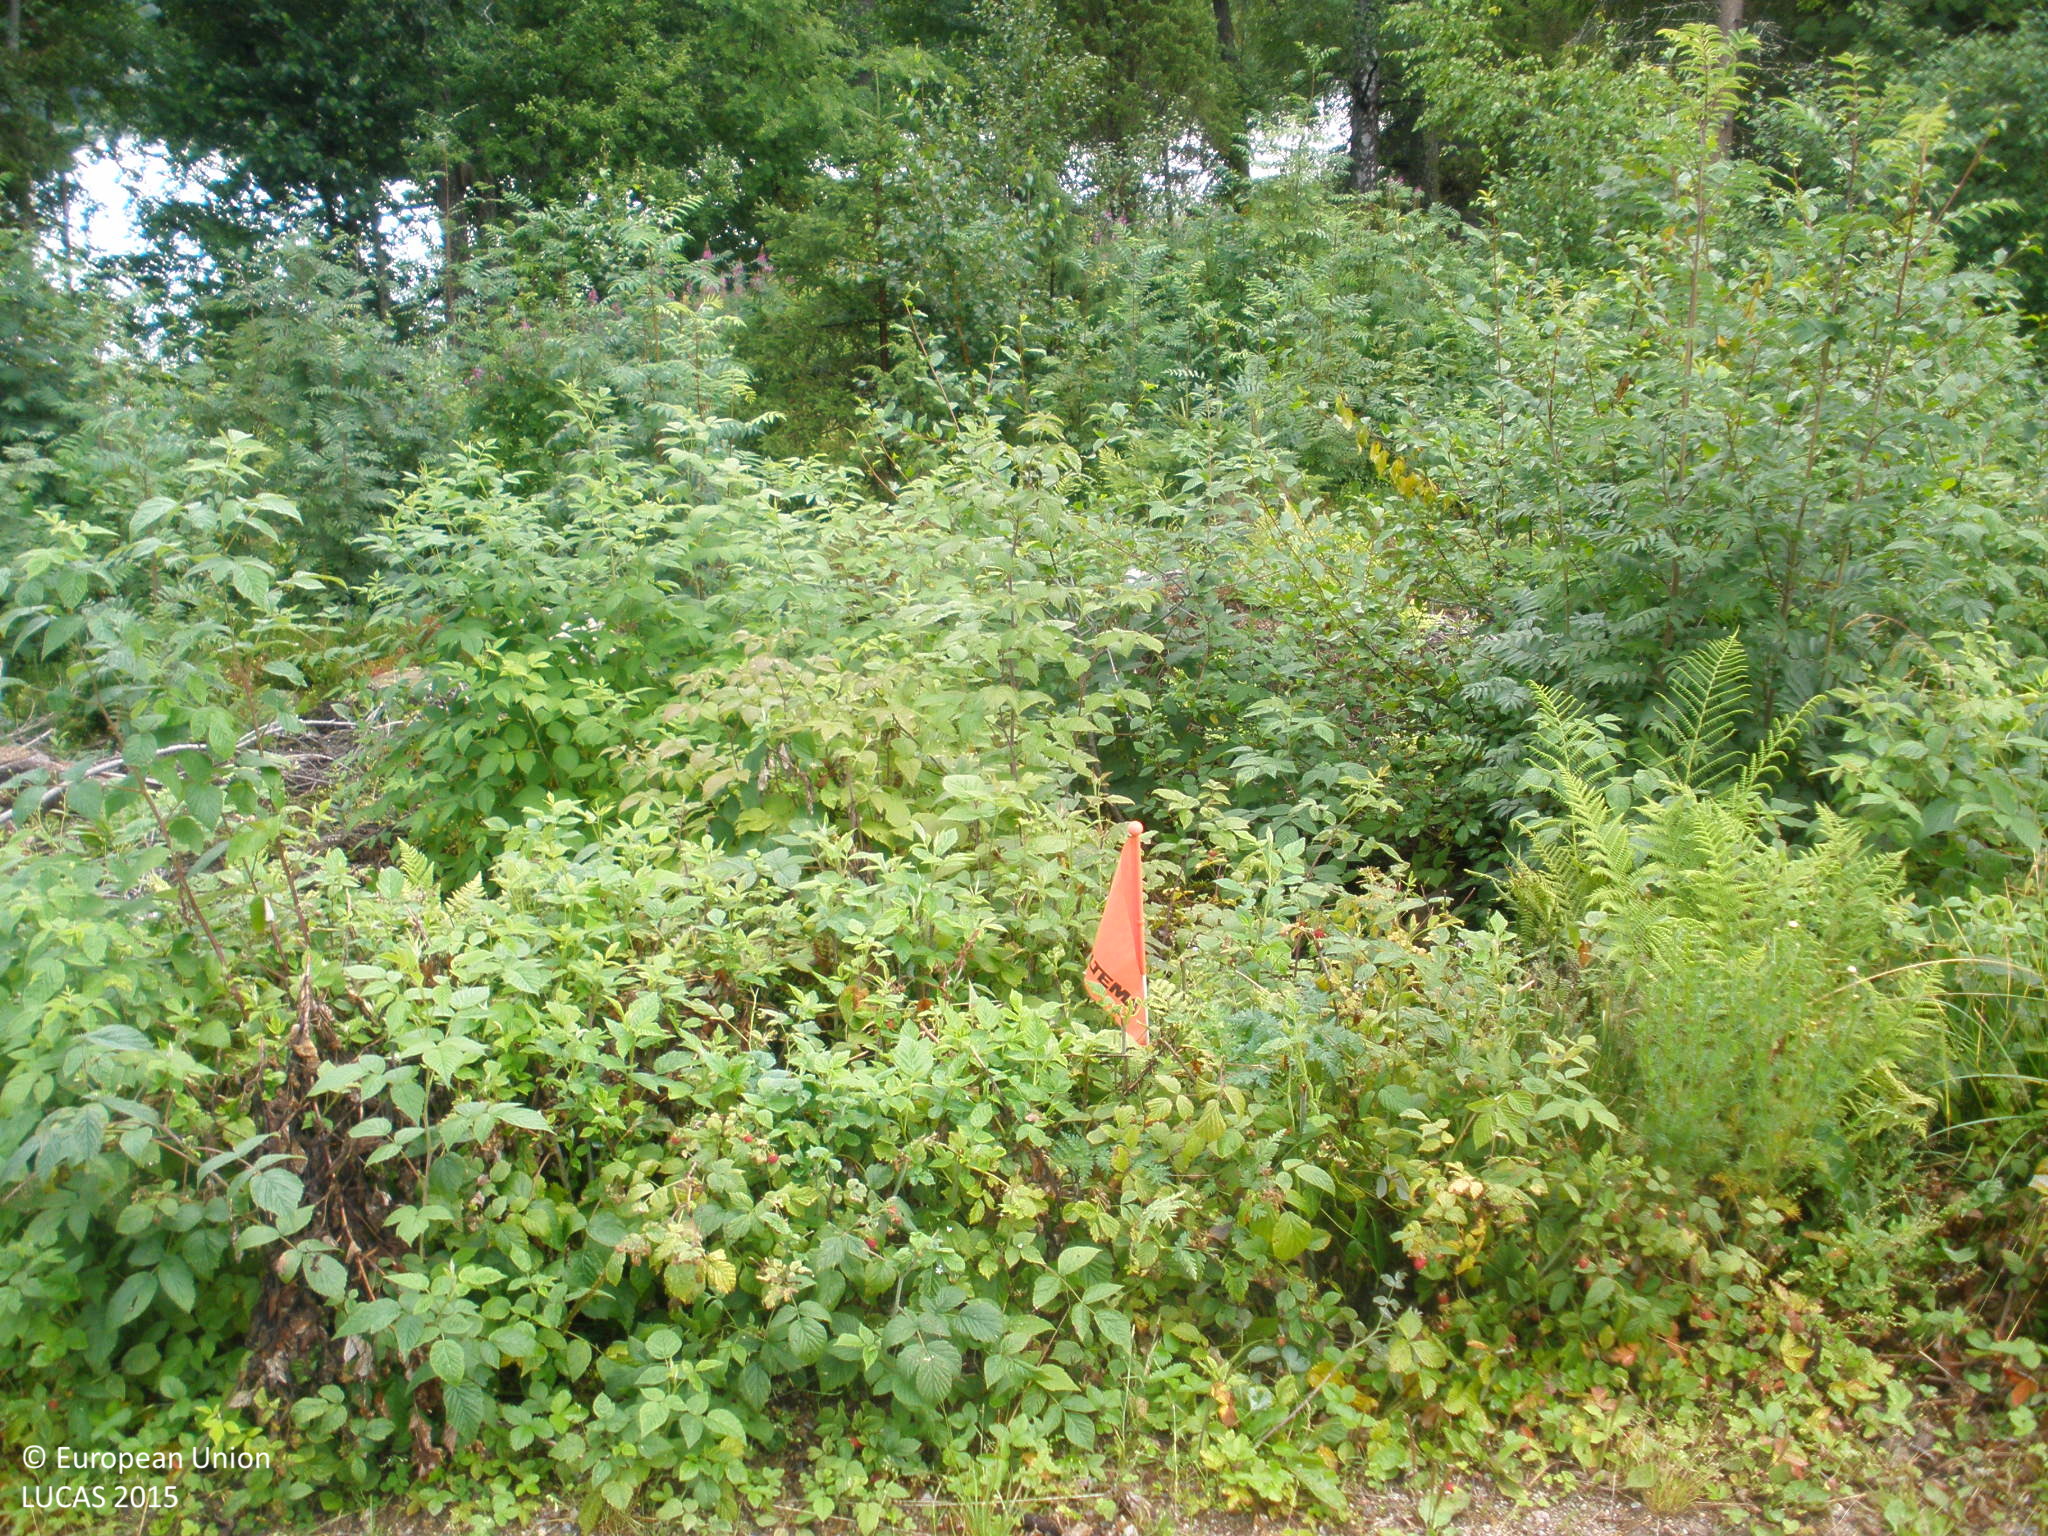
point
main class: Shrubland
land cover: Shrubland with sparse tree cover
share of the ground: 50 - 75 %
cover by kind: shrubs 65 %, herbaceous plants 10 %, consolidated bare surface 10 %, unconsolidated bare surface 10 %, broadleaved forest trees 5 %
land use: Forestry
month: July
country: FI
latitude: 61.2984
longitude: 24.6823
